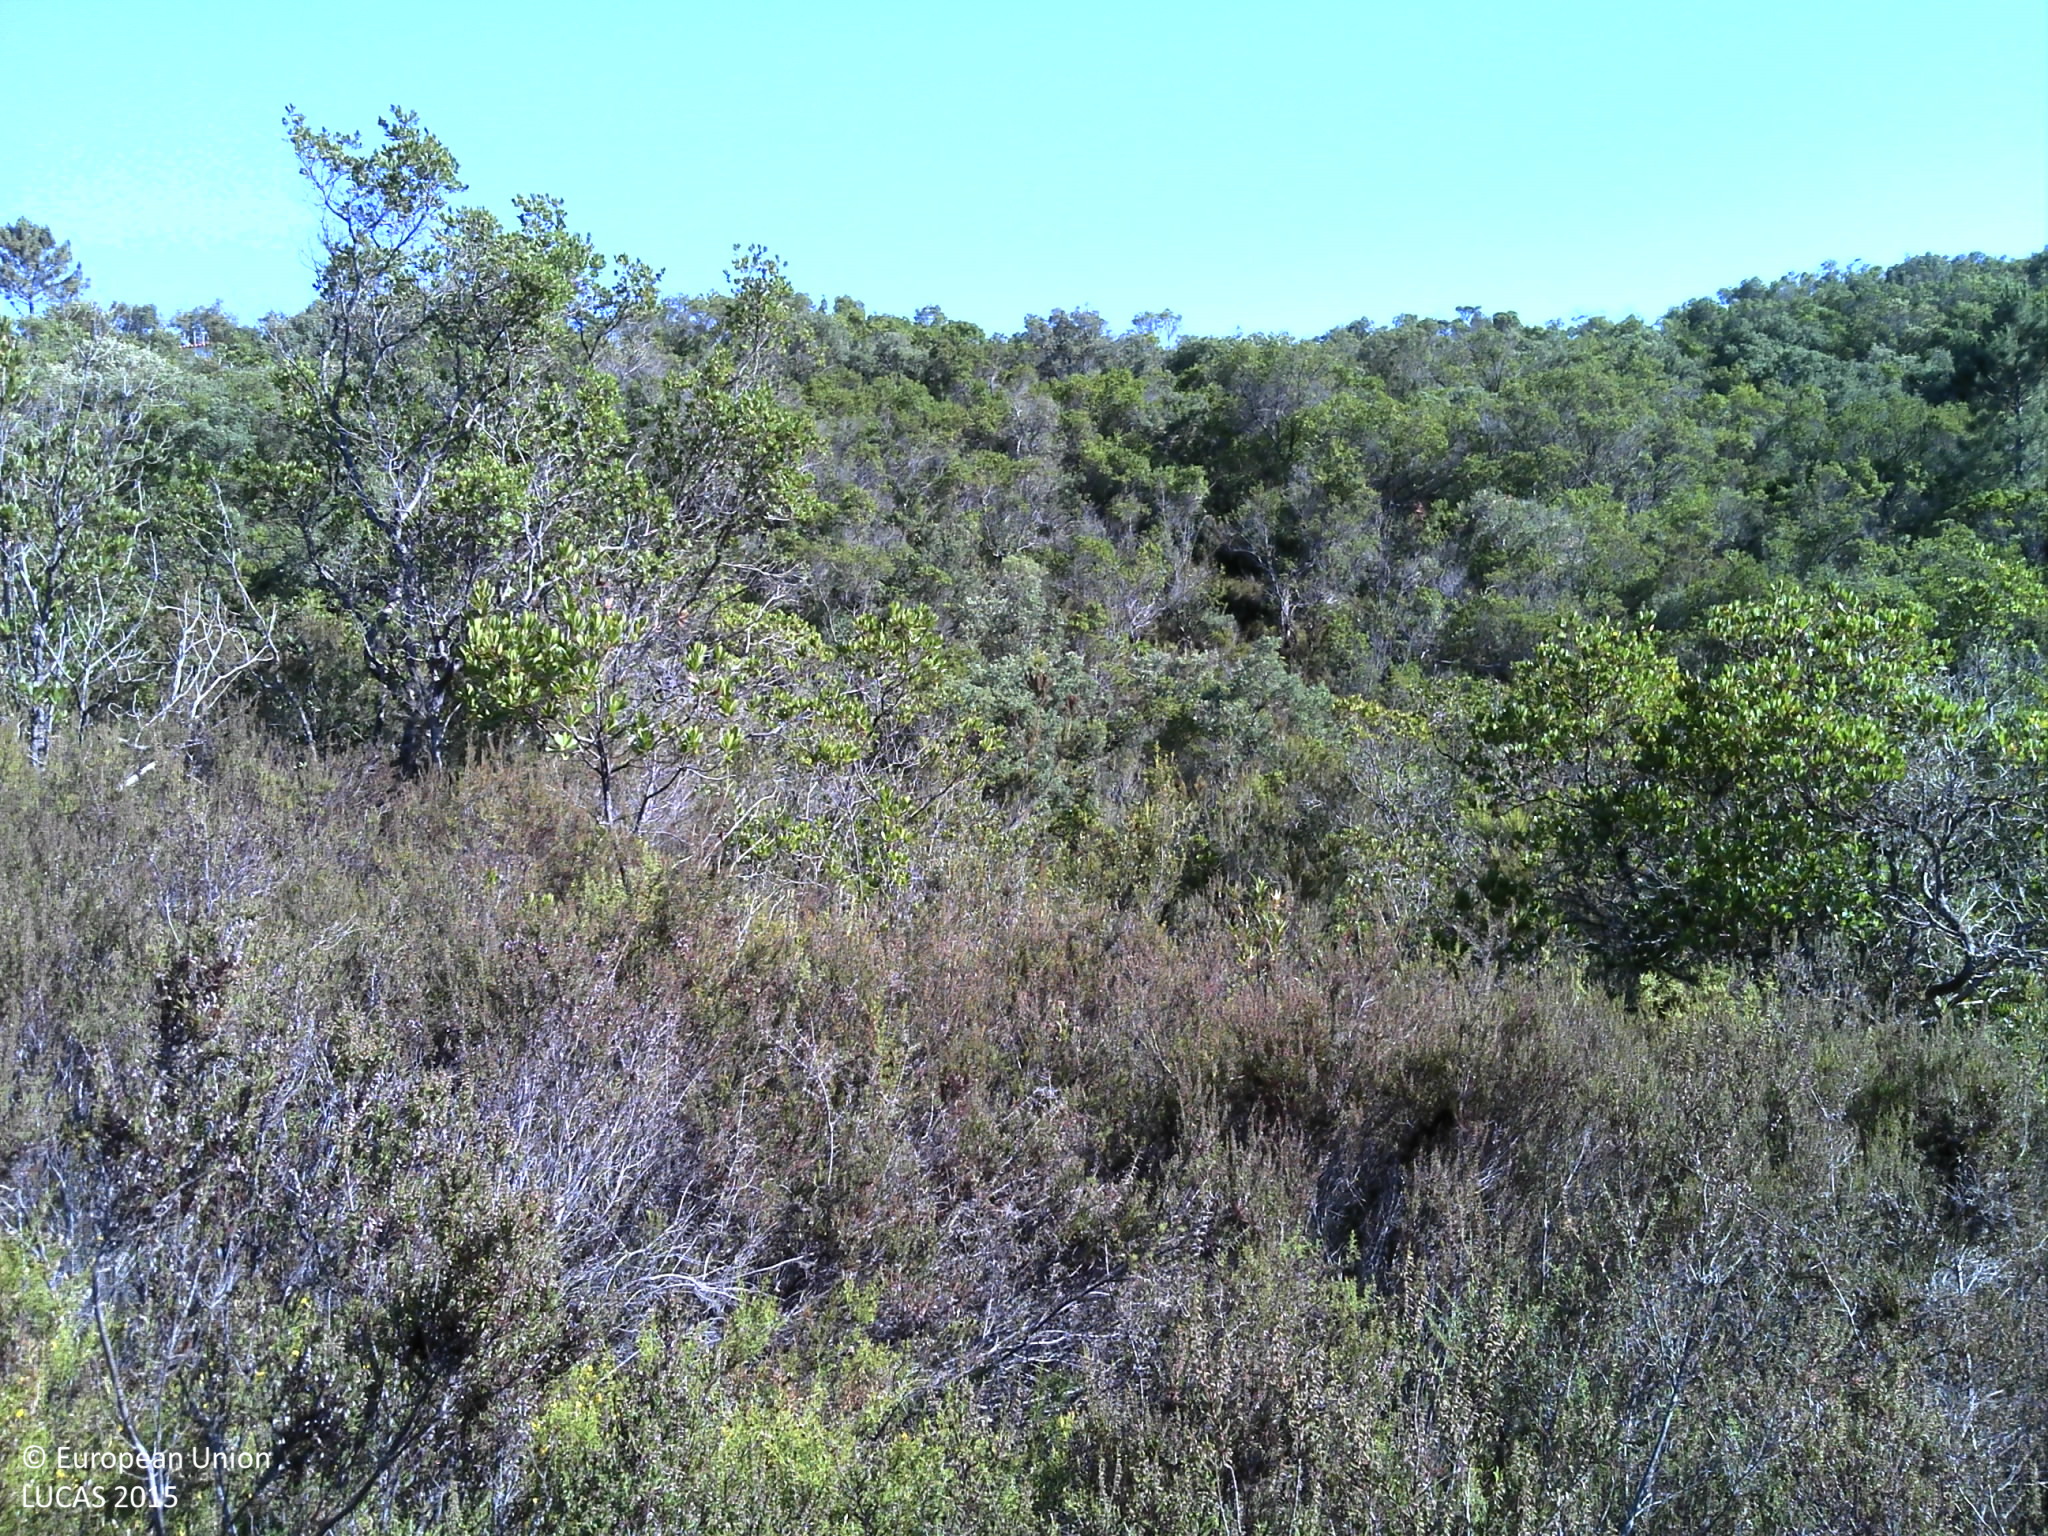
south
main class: Shrubland
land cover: Shrubland with sparse tree cover
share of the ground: > 75 %
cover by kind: shrubs 80 %, herbaceous plants 10 %, broadleaved forest trees 5 %, unconsolidated bare surface 5 %
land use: Forestry
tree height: < 5 m
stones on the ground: < 10 %
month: June
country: PT
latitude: 37.2840
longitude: -8.7923
